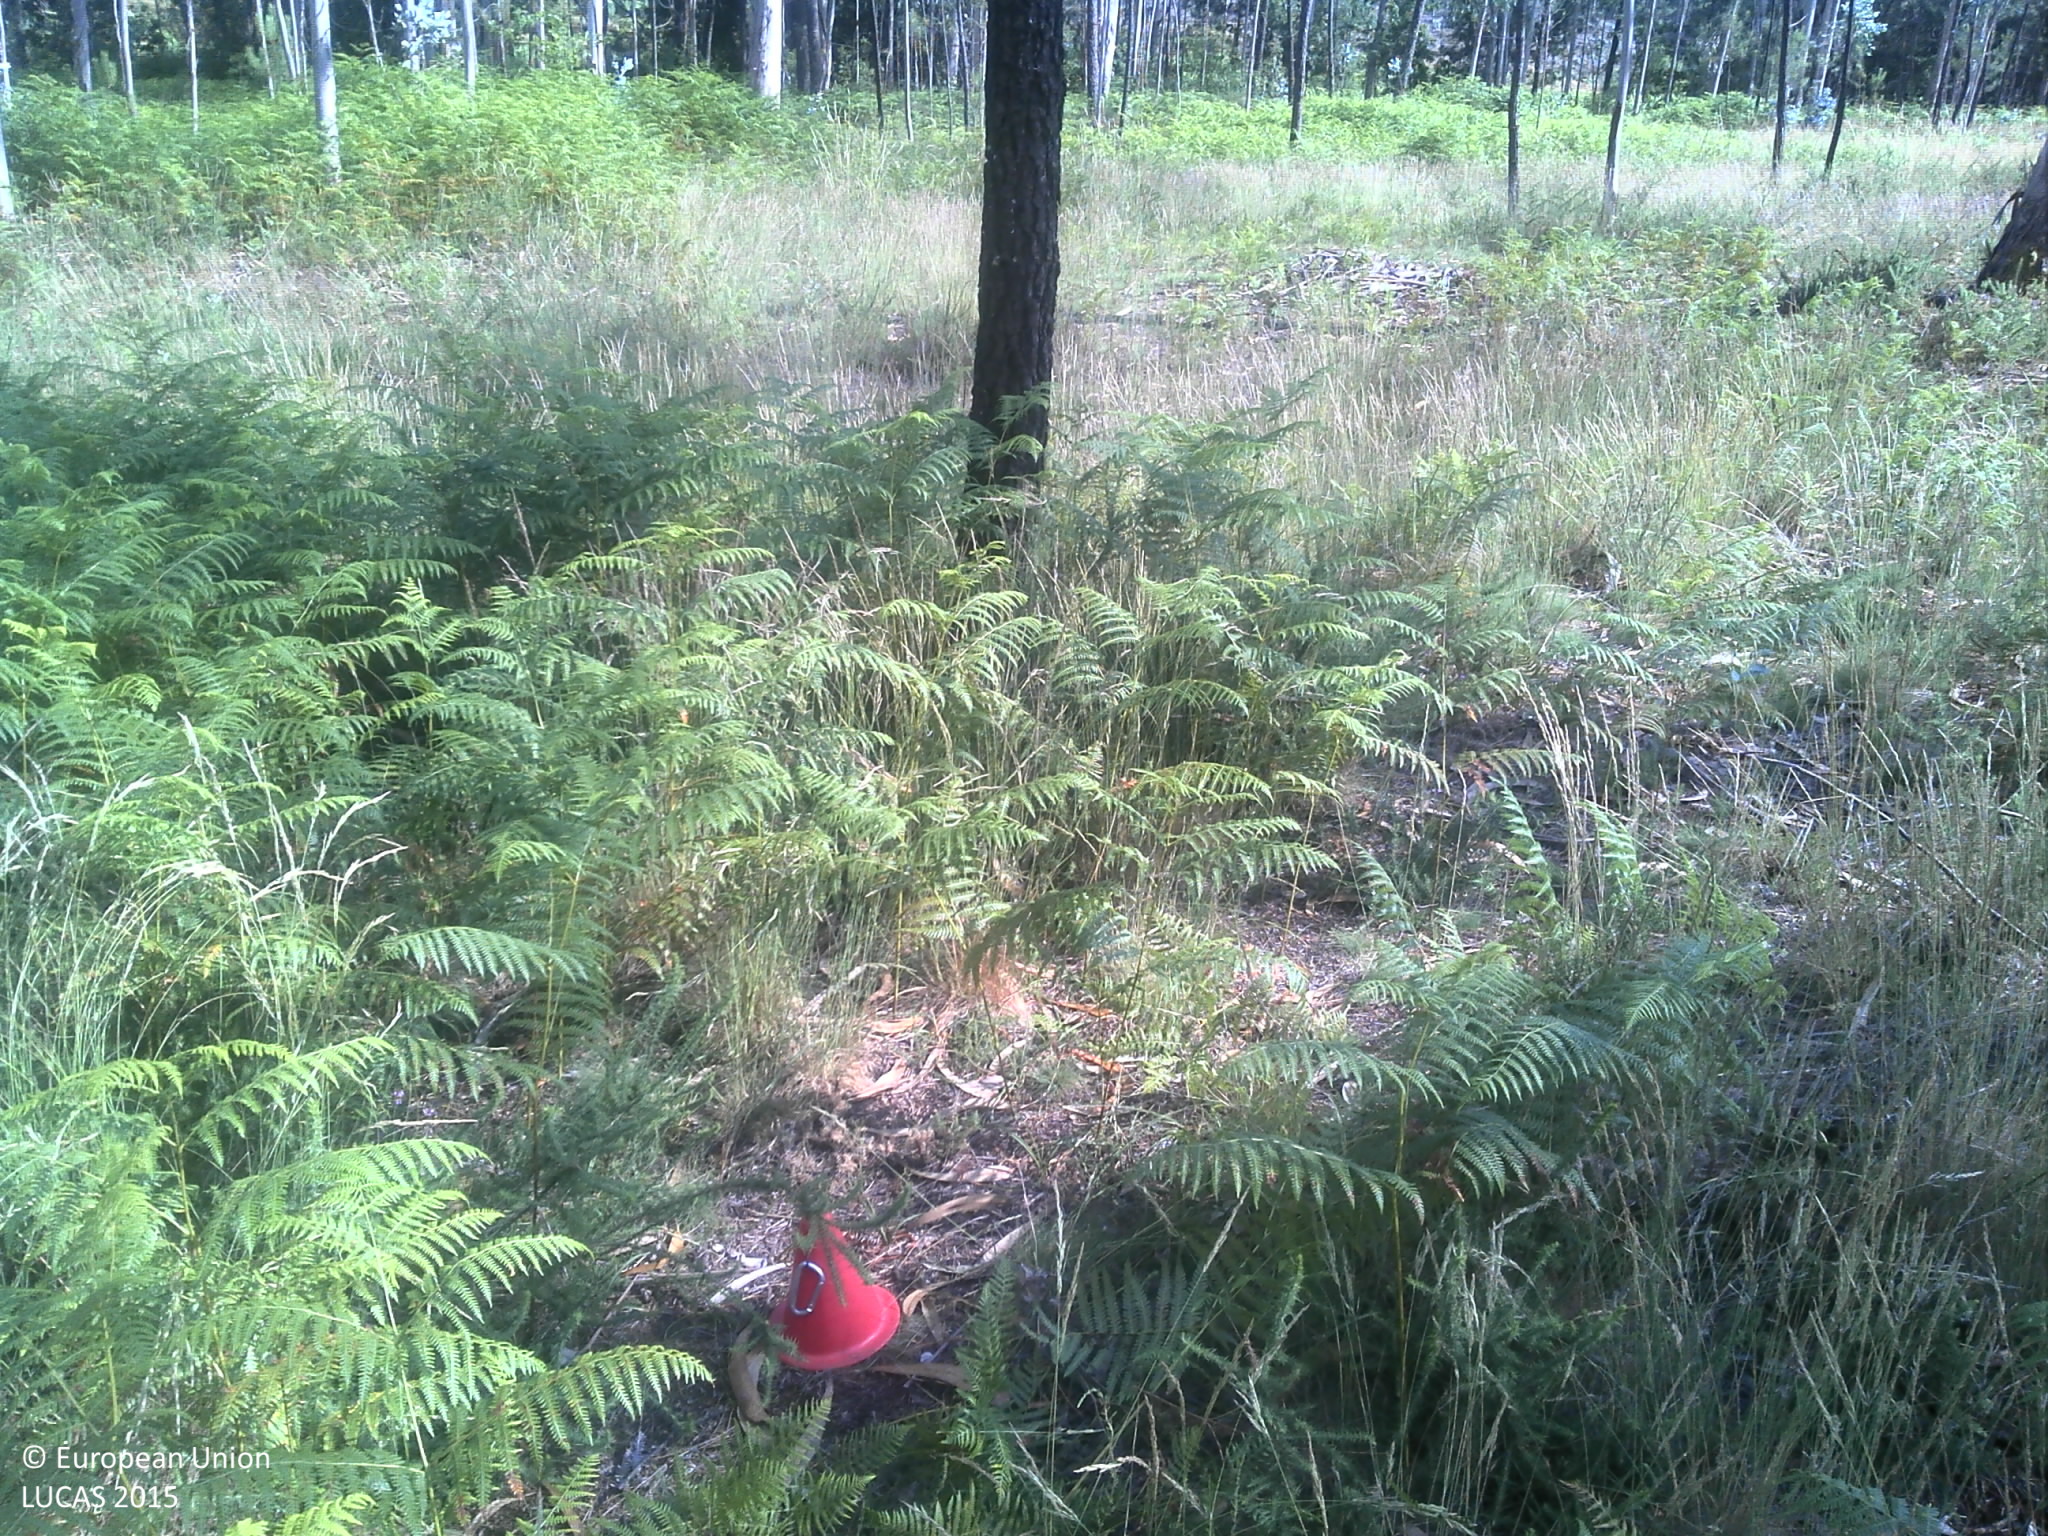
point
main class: Woodland
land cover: Pine dominated mixed woodland
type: coniferous forest of the mediterranean region
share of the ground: 25 - 50 %
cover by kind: coniferous forest trees 75 %, broadleaved forest trees 25 %
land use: Forestry
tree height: > 5 m
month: June
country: PT
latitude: 41.5707
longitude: -8.6412
